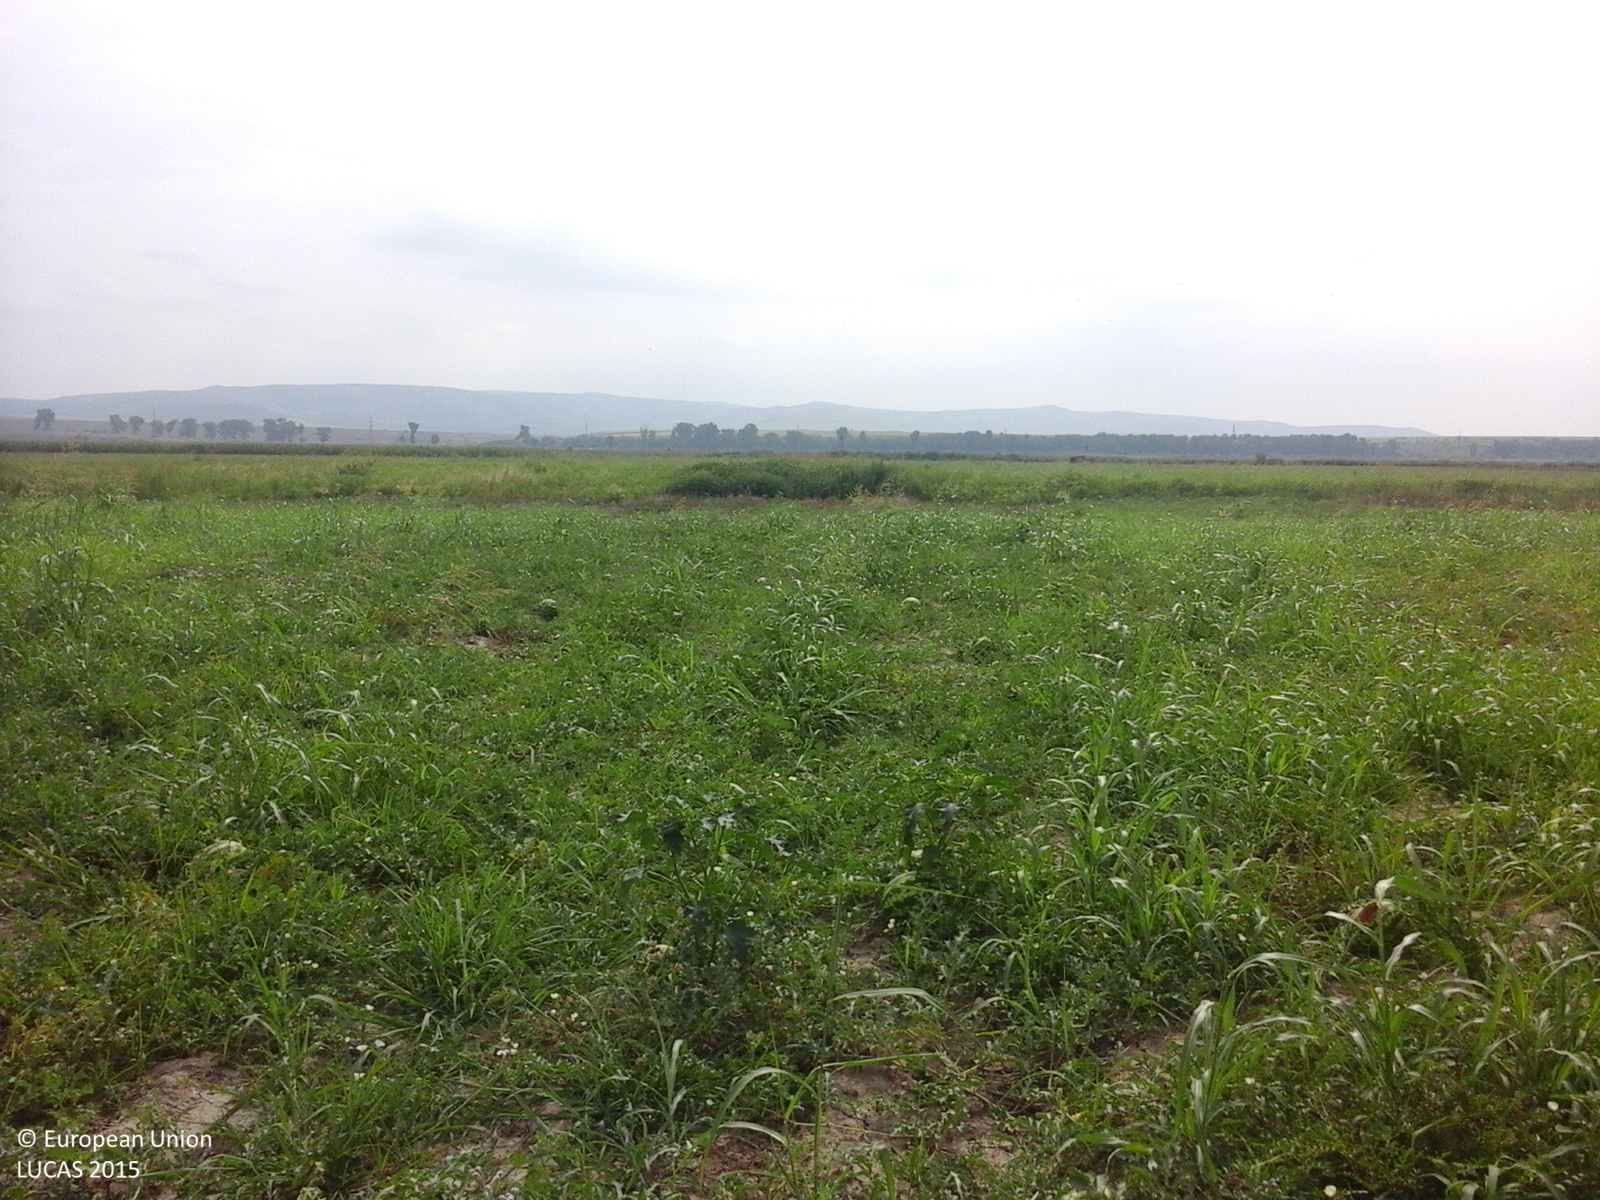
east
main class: Cropland
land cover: Other fresh vegetables
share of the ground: > 75 %
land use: Agriculture (excluding fallow land and kitchen gardens)
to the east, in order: Other fresh vegetables; Spontaneously vegetated surfaces; Other fresh vegetables; Lucerne
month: July
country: RO
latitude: 44.9470
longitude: 28.1524
